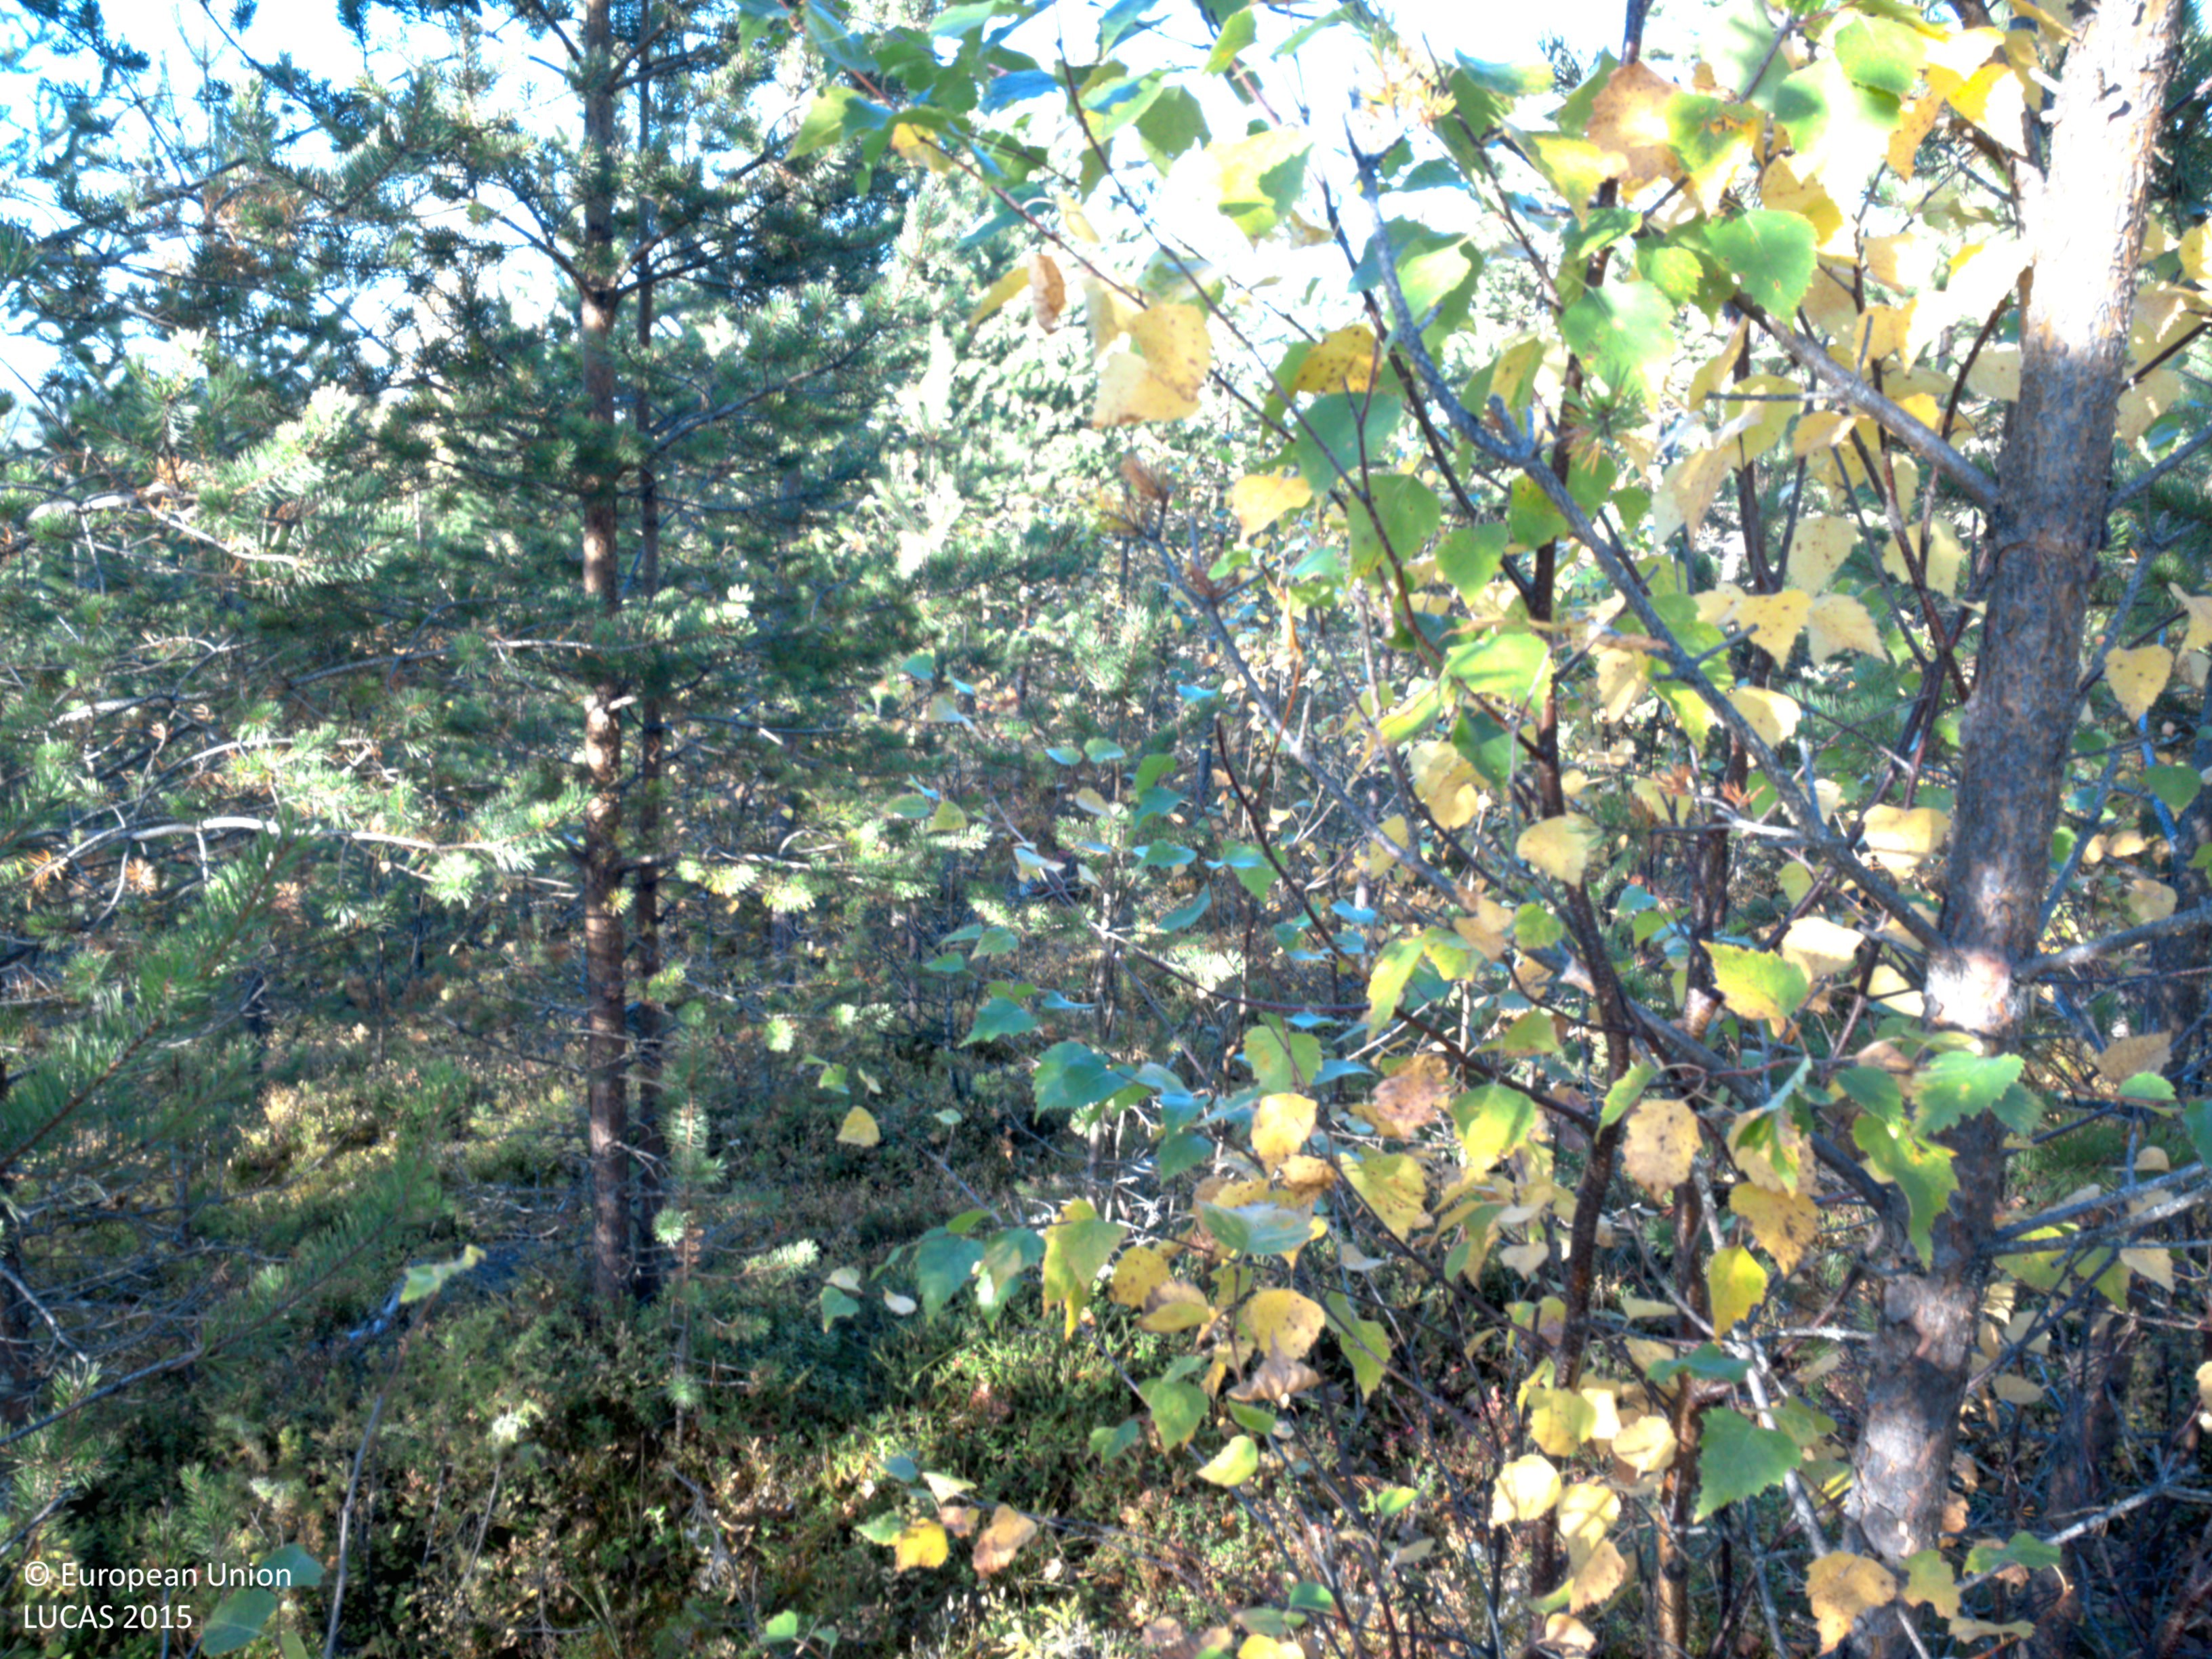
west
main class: Woodland
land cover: Pine dominated coniferous woodland
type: boreal forest
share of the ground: > 75 %
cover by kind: coniferous forest trees 75 %, broadleaved forest trees 10 %, shrubs 10 %, lichens and mosses 5 %
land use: Forestry
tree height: < 5 m
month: September
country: SE
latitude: 64.7376
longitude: 18.7664
